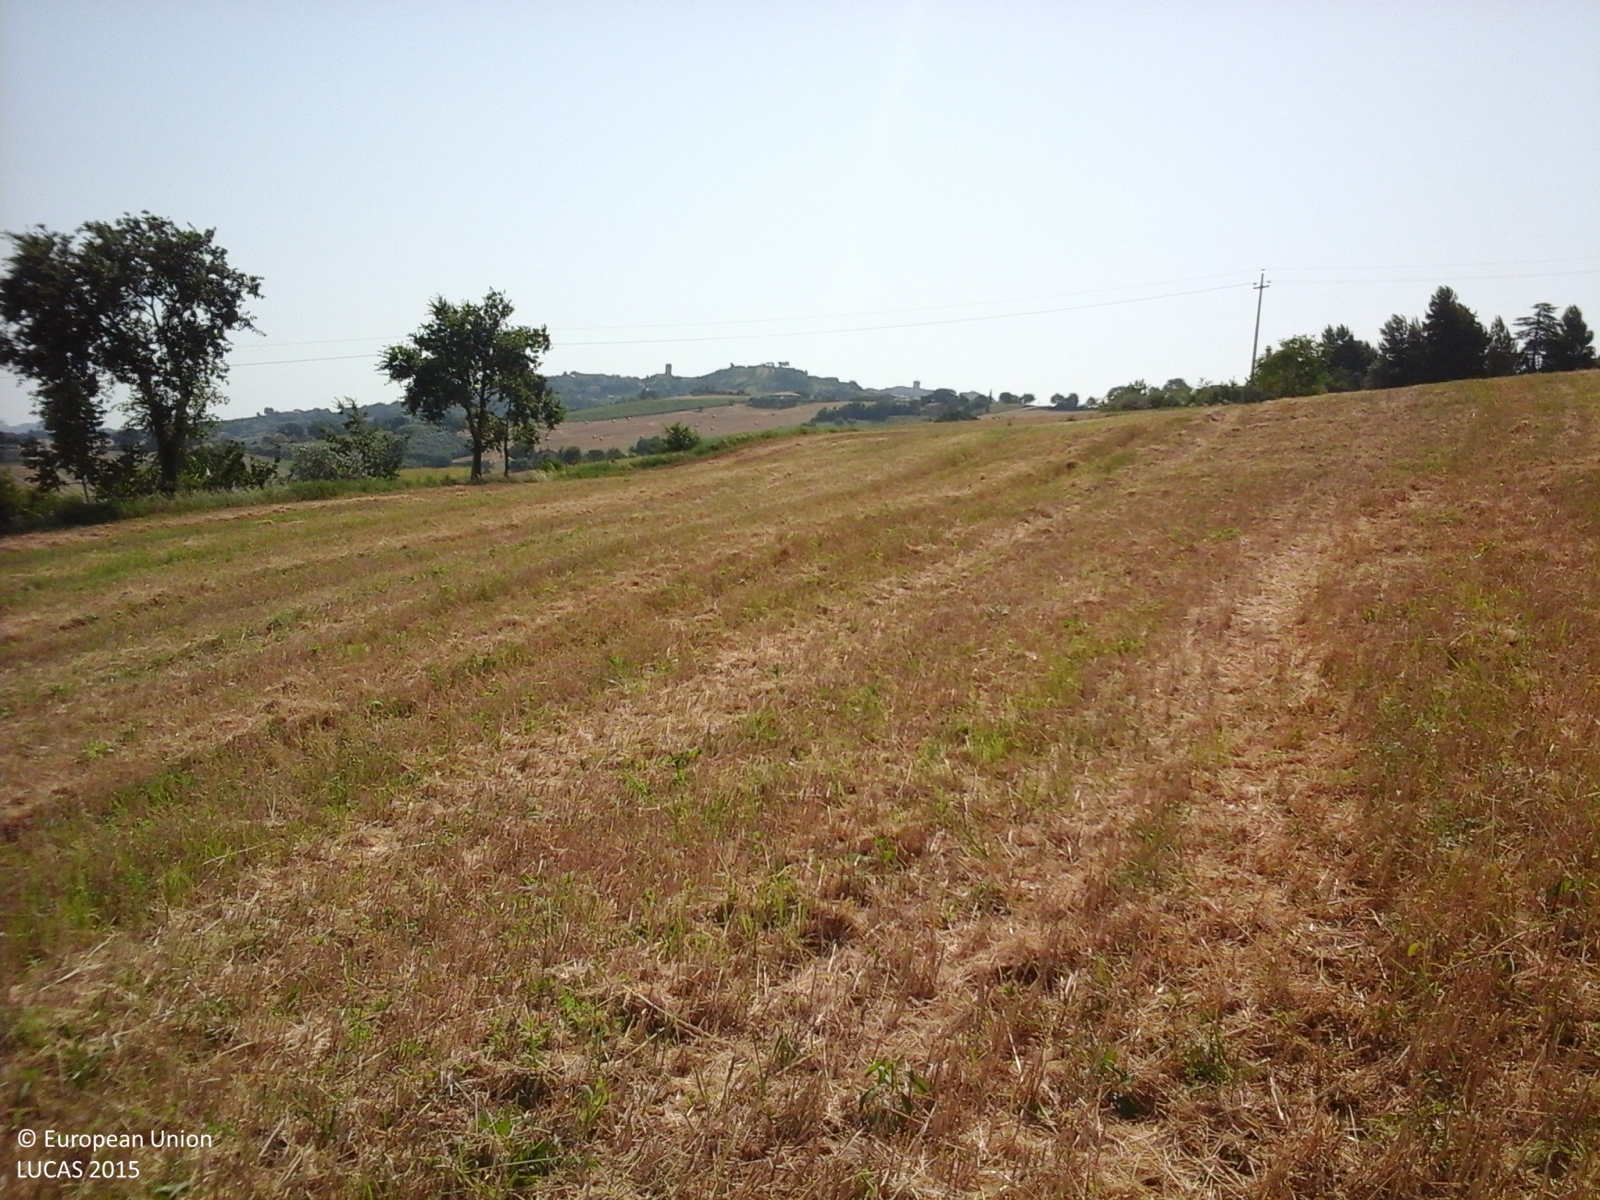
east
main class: Cropland
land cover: Durum wheat
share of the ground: > 75 %
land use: Agriculture (excluding fallow land and kitchen gardens)
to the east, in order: Durum wheat; Grass margins; Ditches and canals; Tracks; Electric lines; Grass margins; Durum wheat
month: July
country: IT
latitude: 43.4064
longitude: 13.5106
